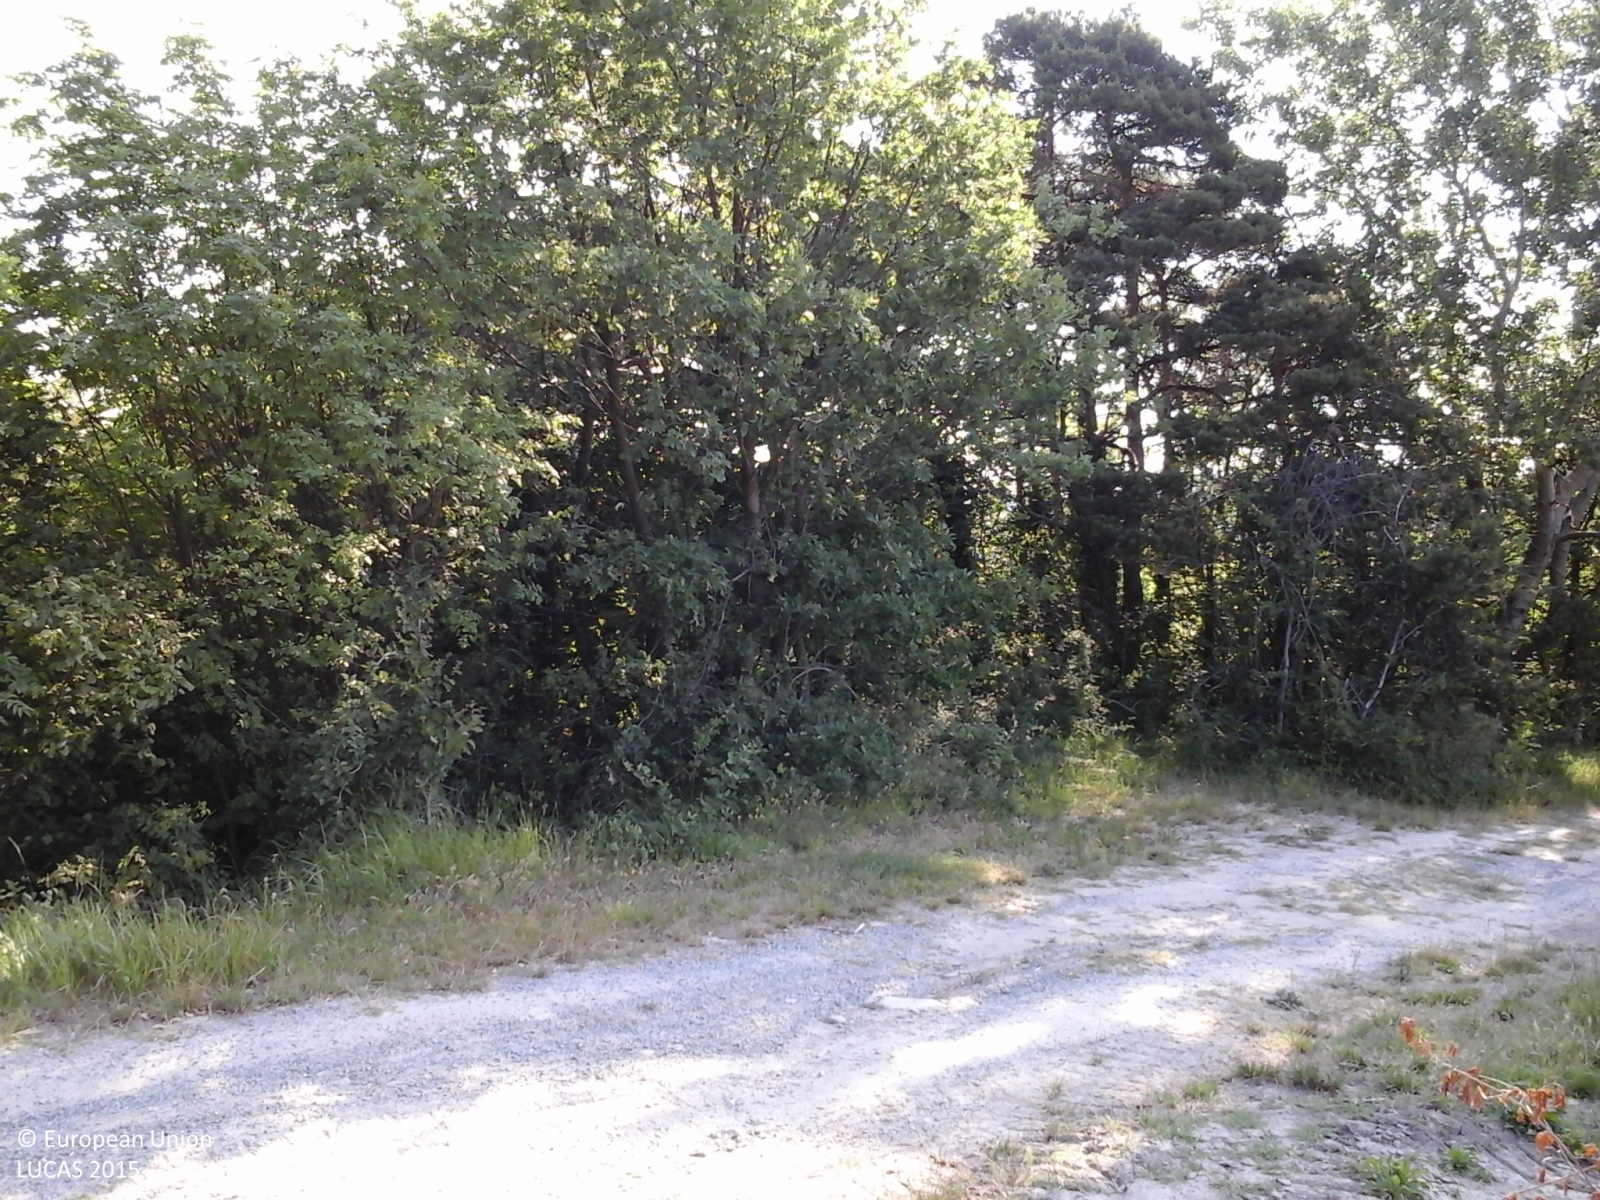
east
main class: Woodland
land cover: Broadleaved woodland
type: mesophytic deciduous forest
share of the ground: > 75 %
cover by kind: broadleaved forest trees 95 %, shrubs 5 %
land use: Forestry
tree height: > 5 m
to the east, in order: Broadleaved woodland; Tracks; Broadleaved woodland; Rivers and streams; Broadleaved woodland
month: June
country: IT
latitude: 44.6798
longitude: 8.3255
